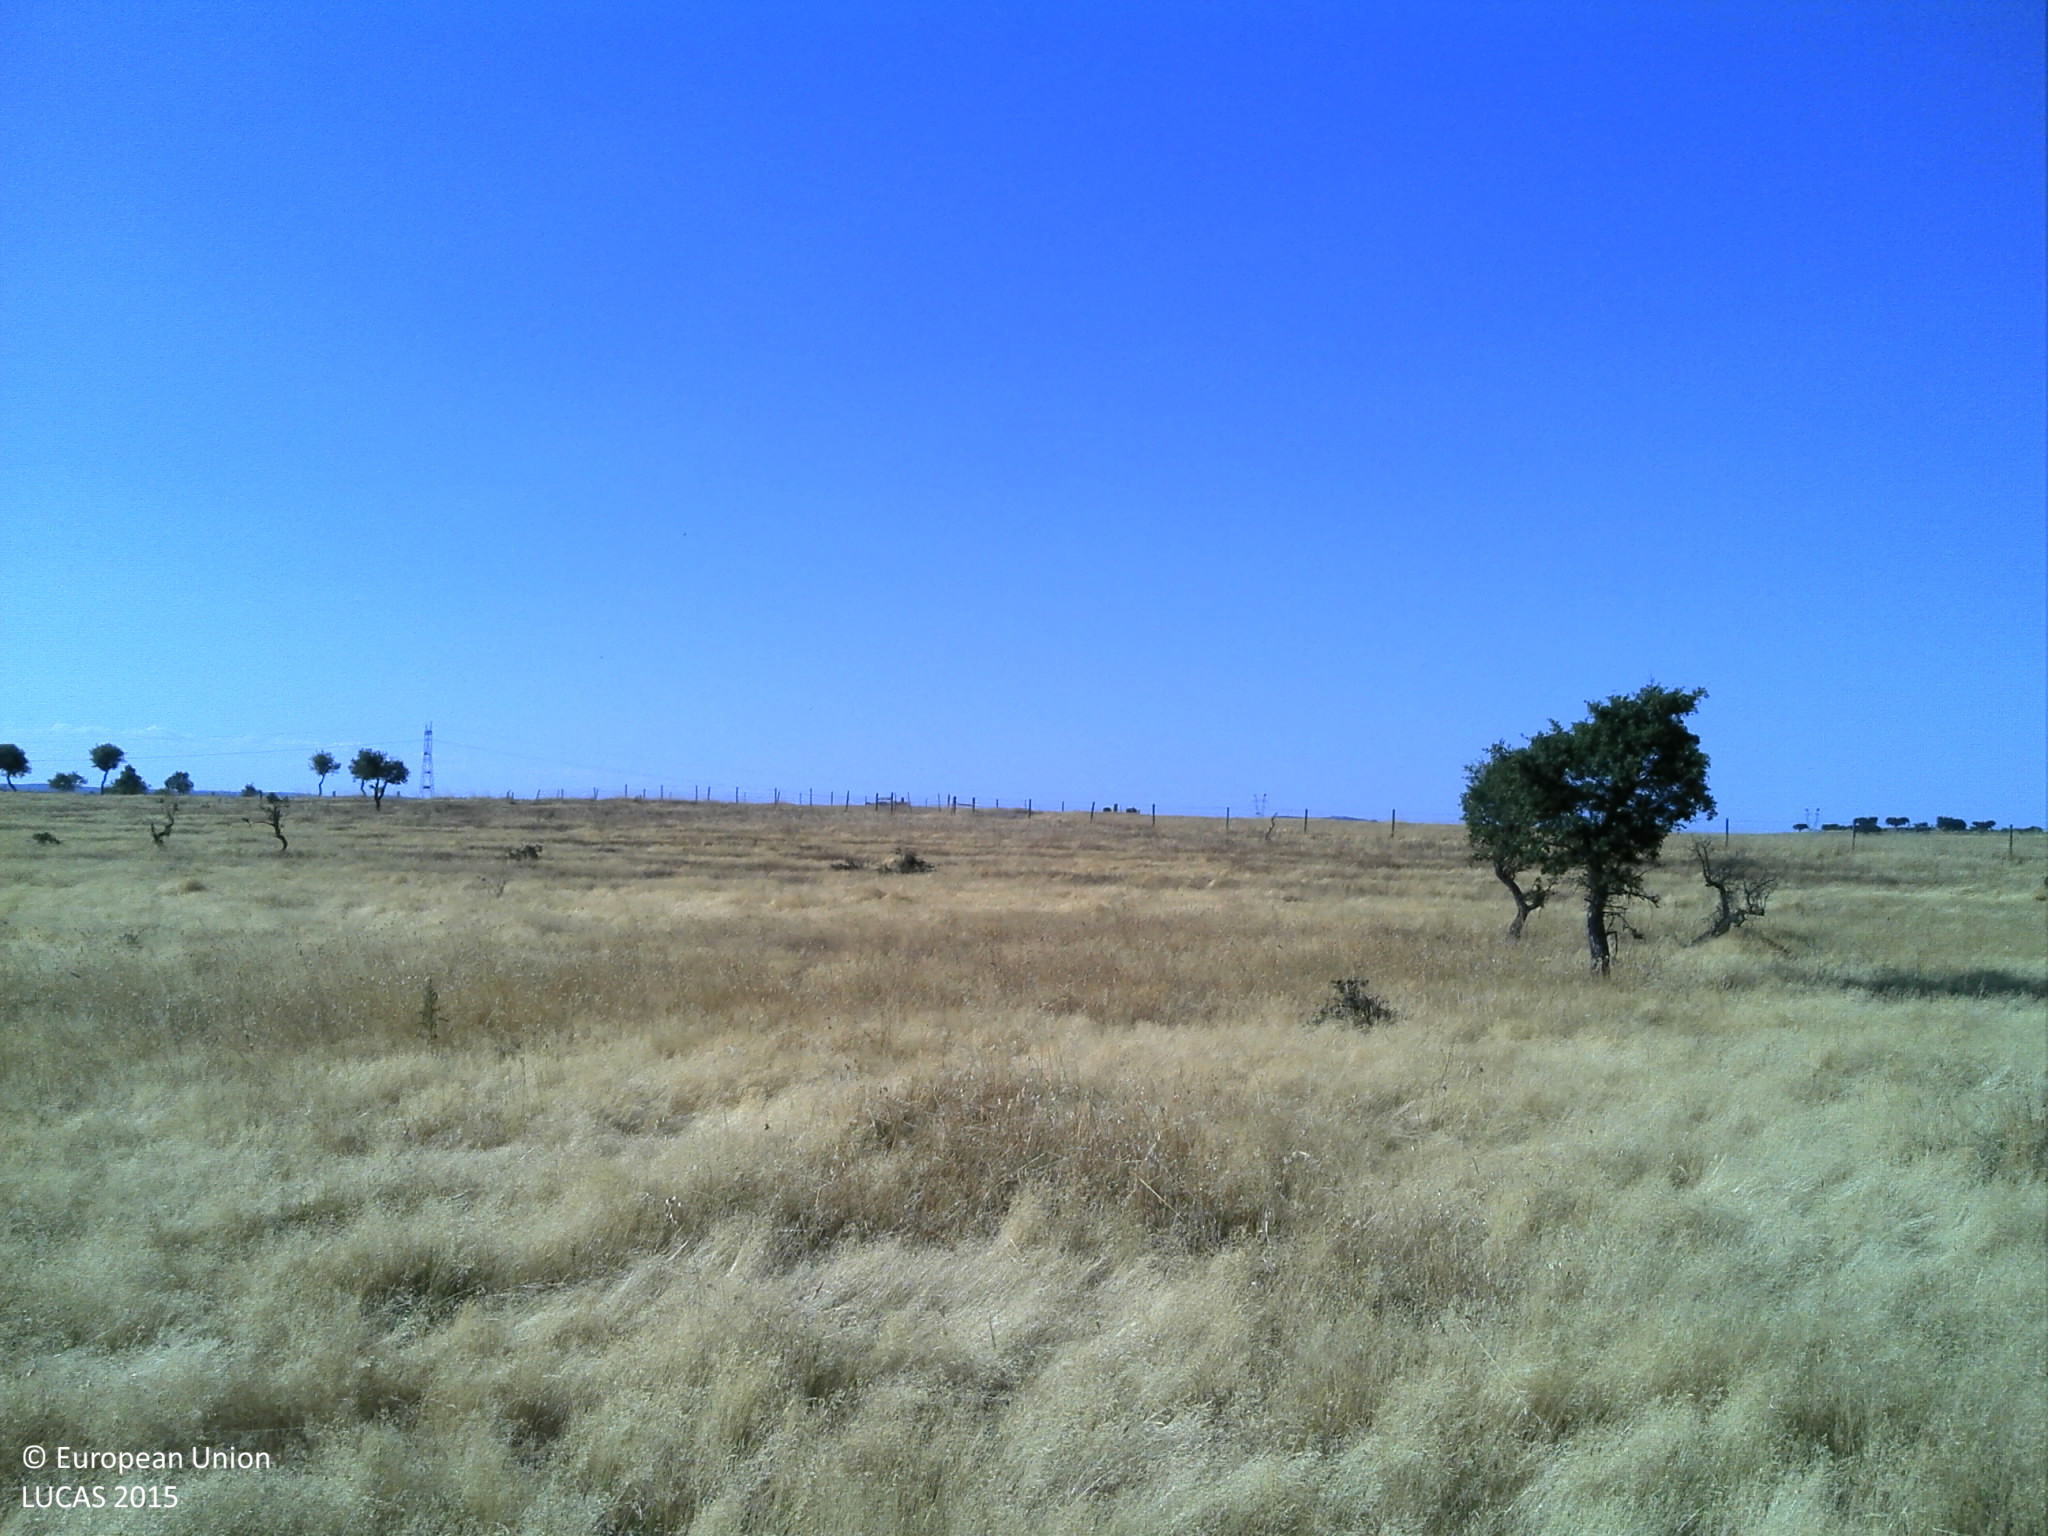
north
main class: Woodland
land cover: Broadleaved woodland
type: broadleaved evergreen forest
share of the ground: 10 - 25 %
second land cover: Grassland without tree/shrub cover
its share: 25 - 50 %
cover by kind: unconsolidated bare surface 65 %, herbaceous plants 25 %, broadleaved forest trees 10 %
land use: Forestry
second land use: Agriculture (excluding fallow land and kitchen gardens)
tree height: < 5 m
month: June
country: PT
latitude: 38.4624
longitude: -7.9746
